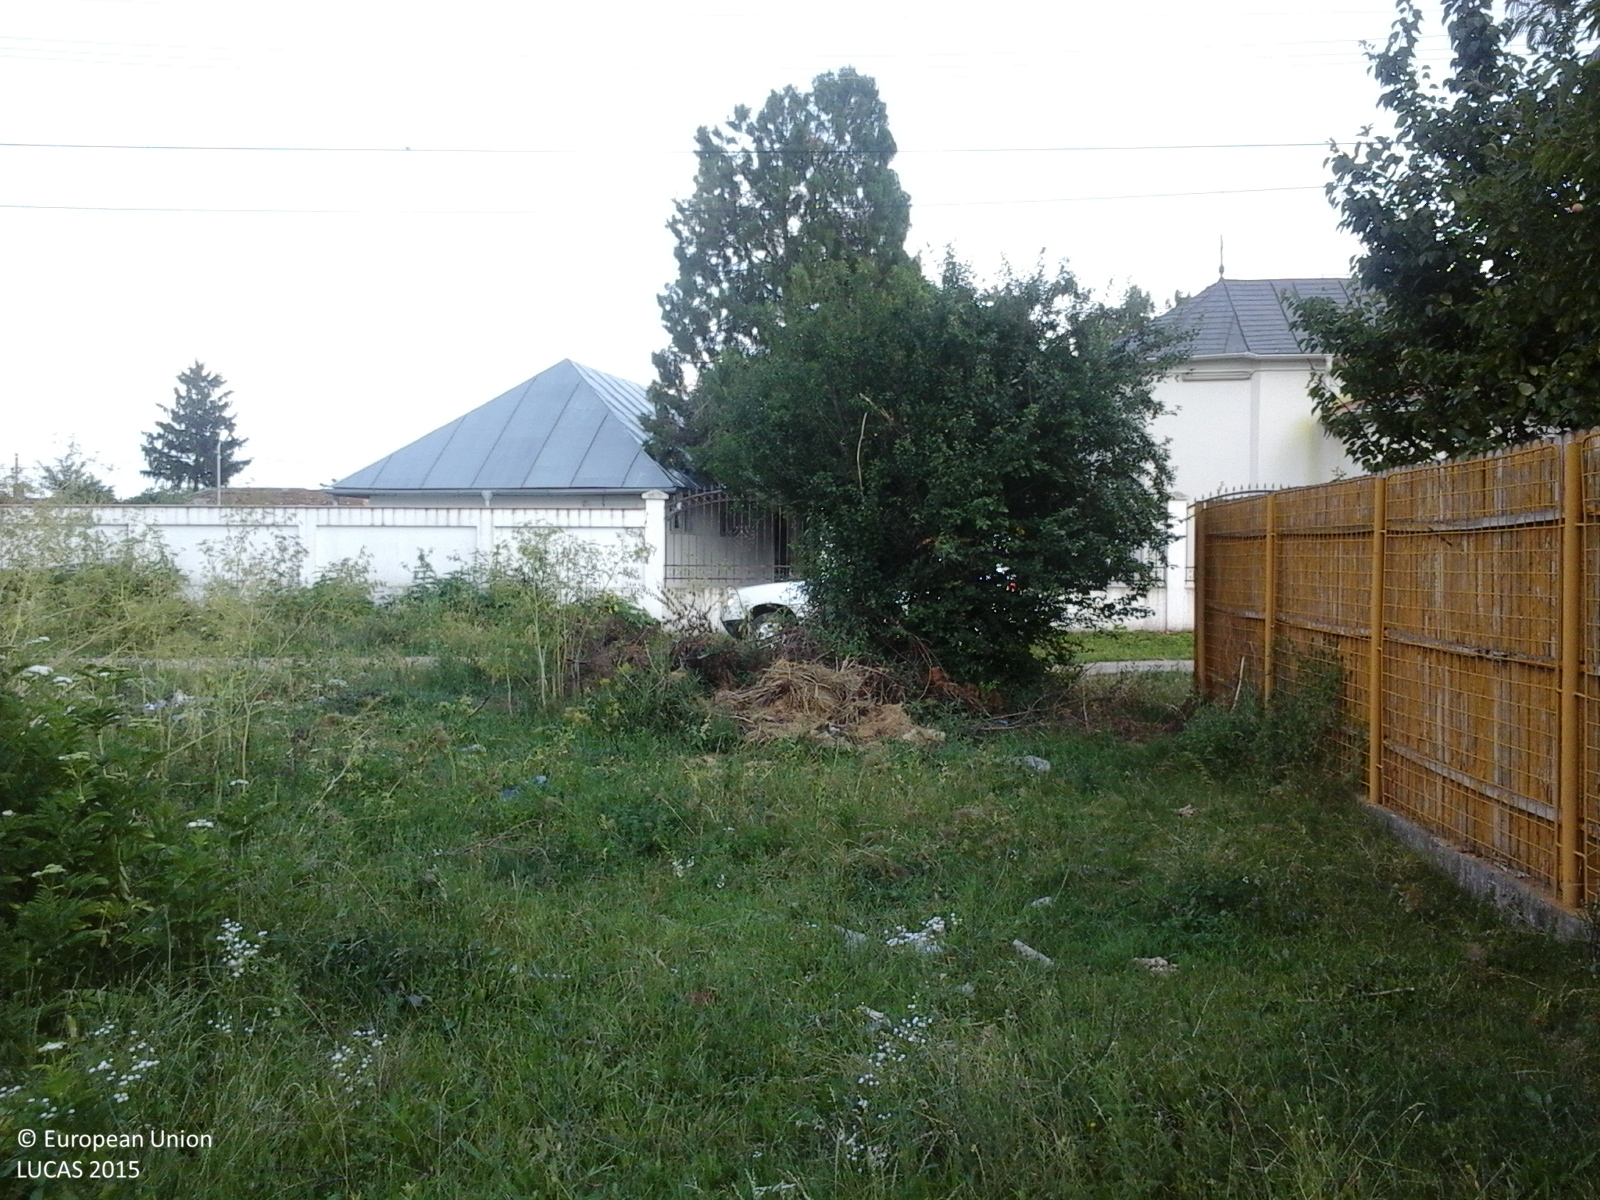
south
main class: Grassland
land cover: Grassland with sparse tree/shrub cover
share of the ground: > 75 %
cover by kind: herbaceous plants 95 %, broadleaved forest trees 5 %
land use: Agriculture (excluding fallow land and kitchen gardens)
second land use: Residential
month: June
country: RO
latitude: 44.5359
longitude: 26.2045
